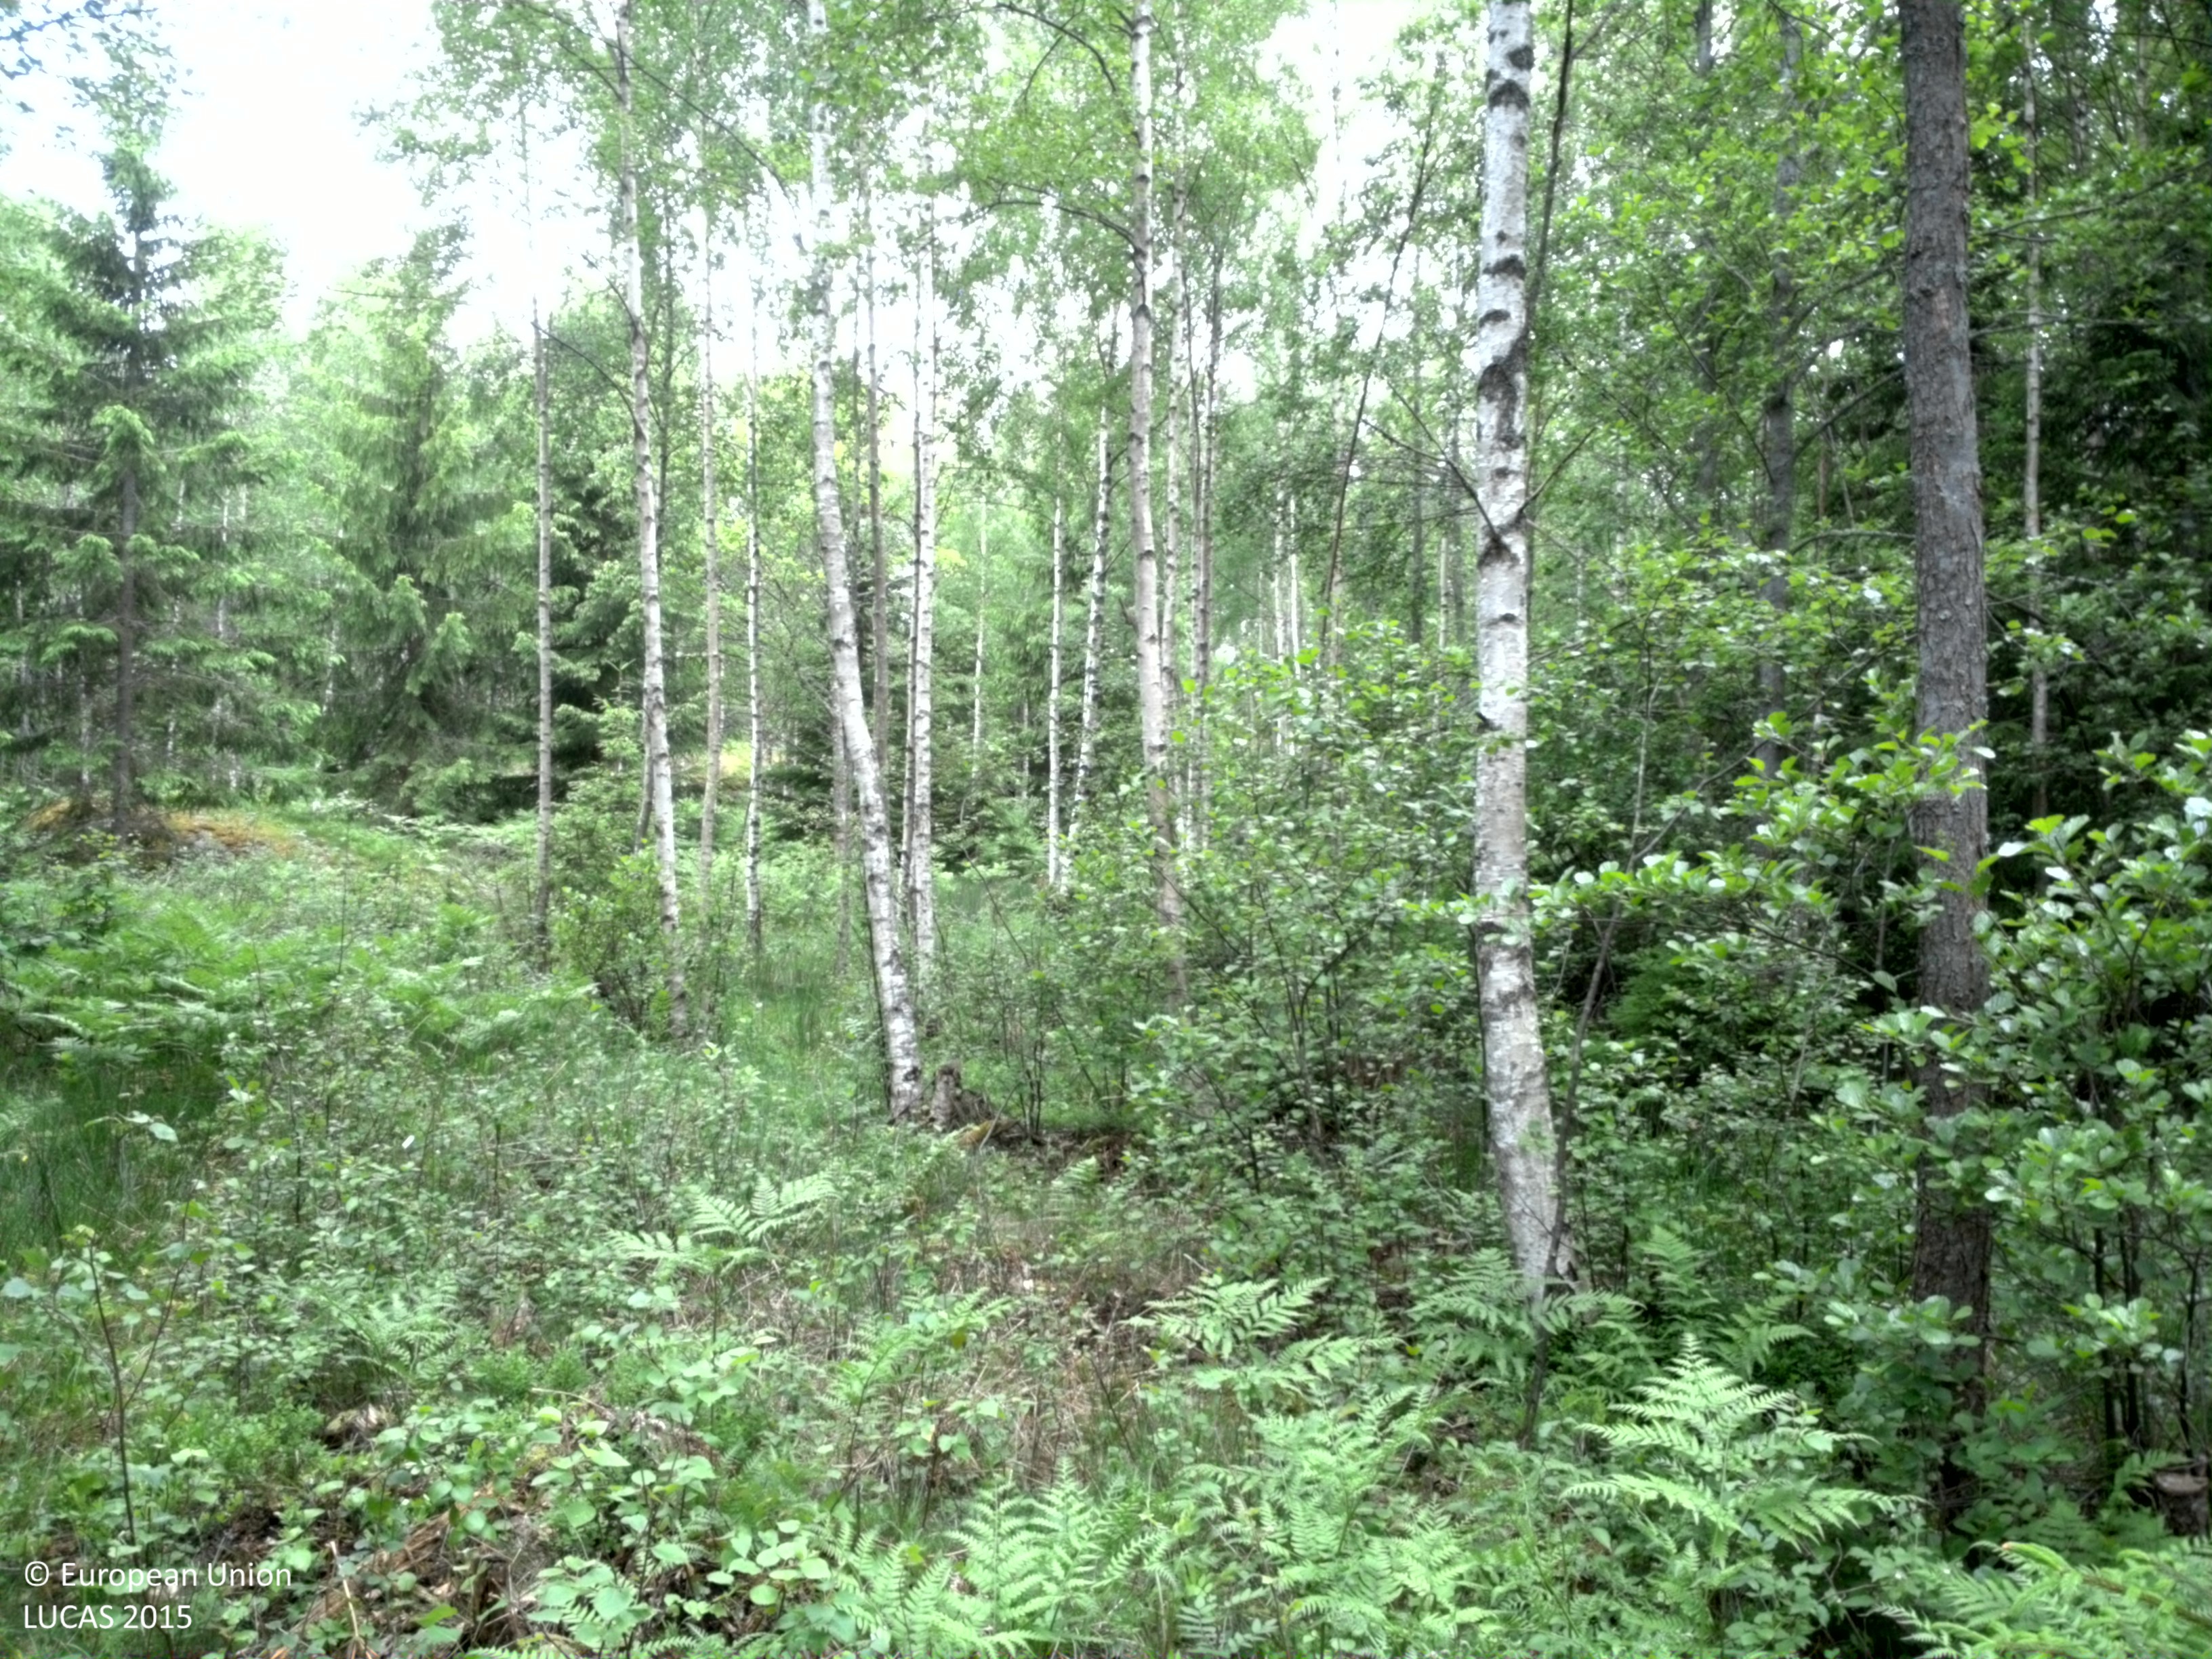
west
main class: Woodland
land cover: Spruce dominated mixed woodland
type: boreal forest
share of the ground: 50 - 75 %
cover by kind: coniferous forest trees 45 %, herbaceous plants 30 %, broadleaved forest trees 15 %, lichens and mosses 10 %
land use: Forestry
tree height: > 5 m
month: June
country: SE
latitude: 59.6905
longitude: 18.7586
